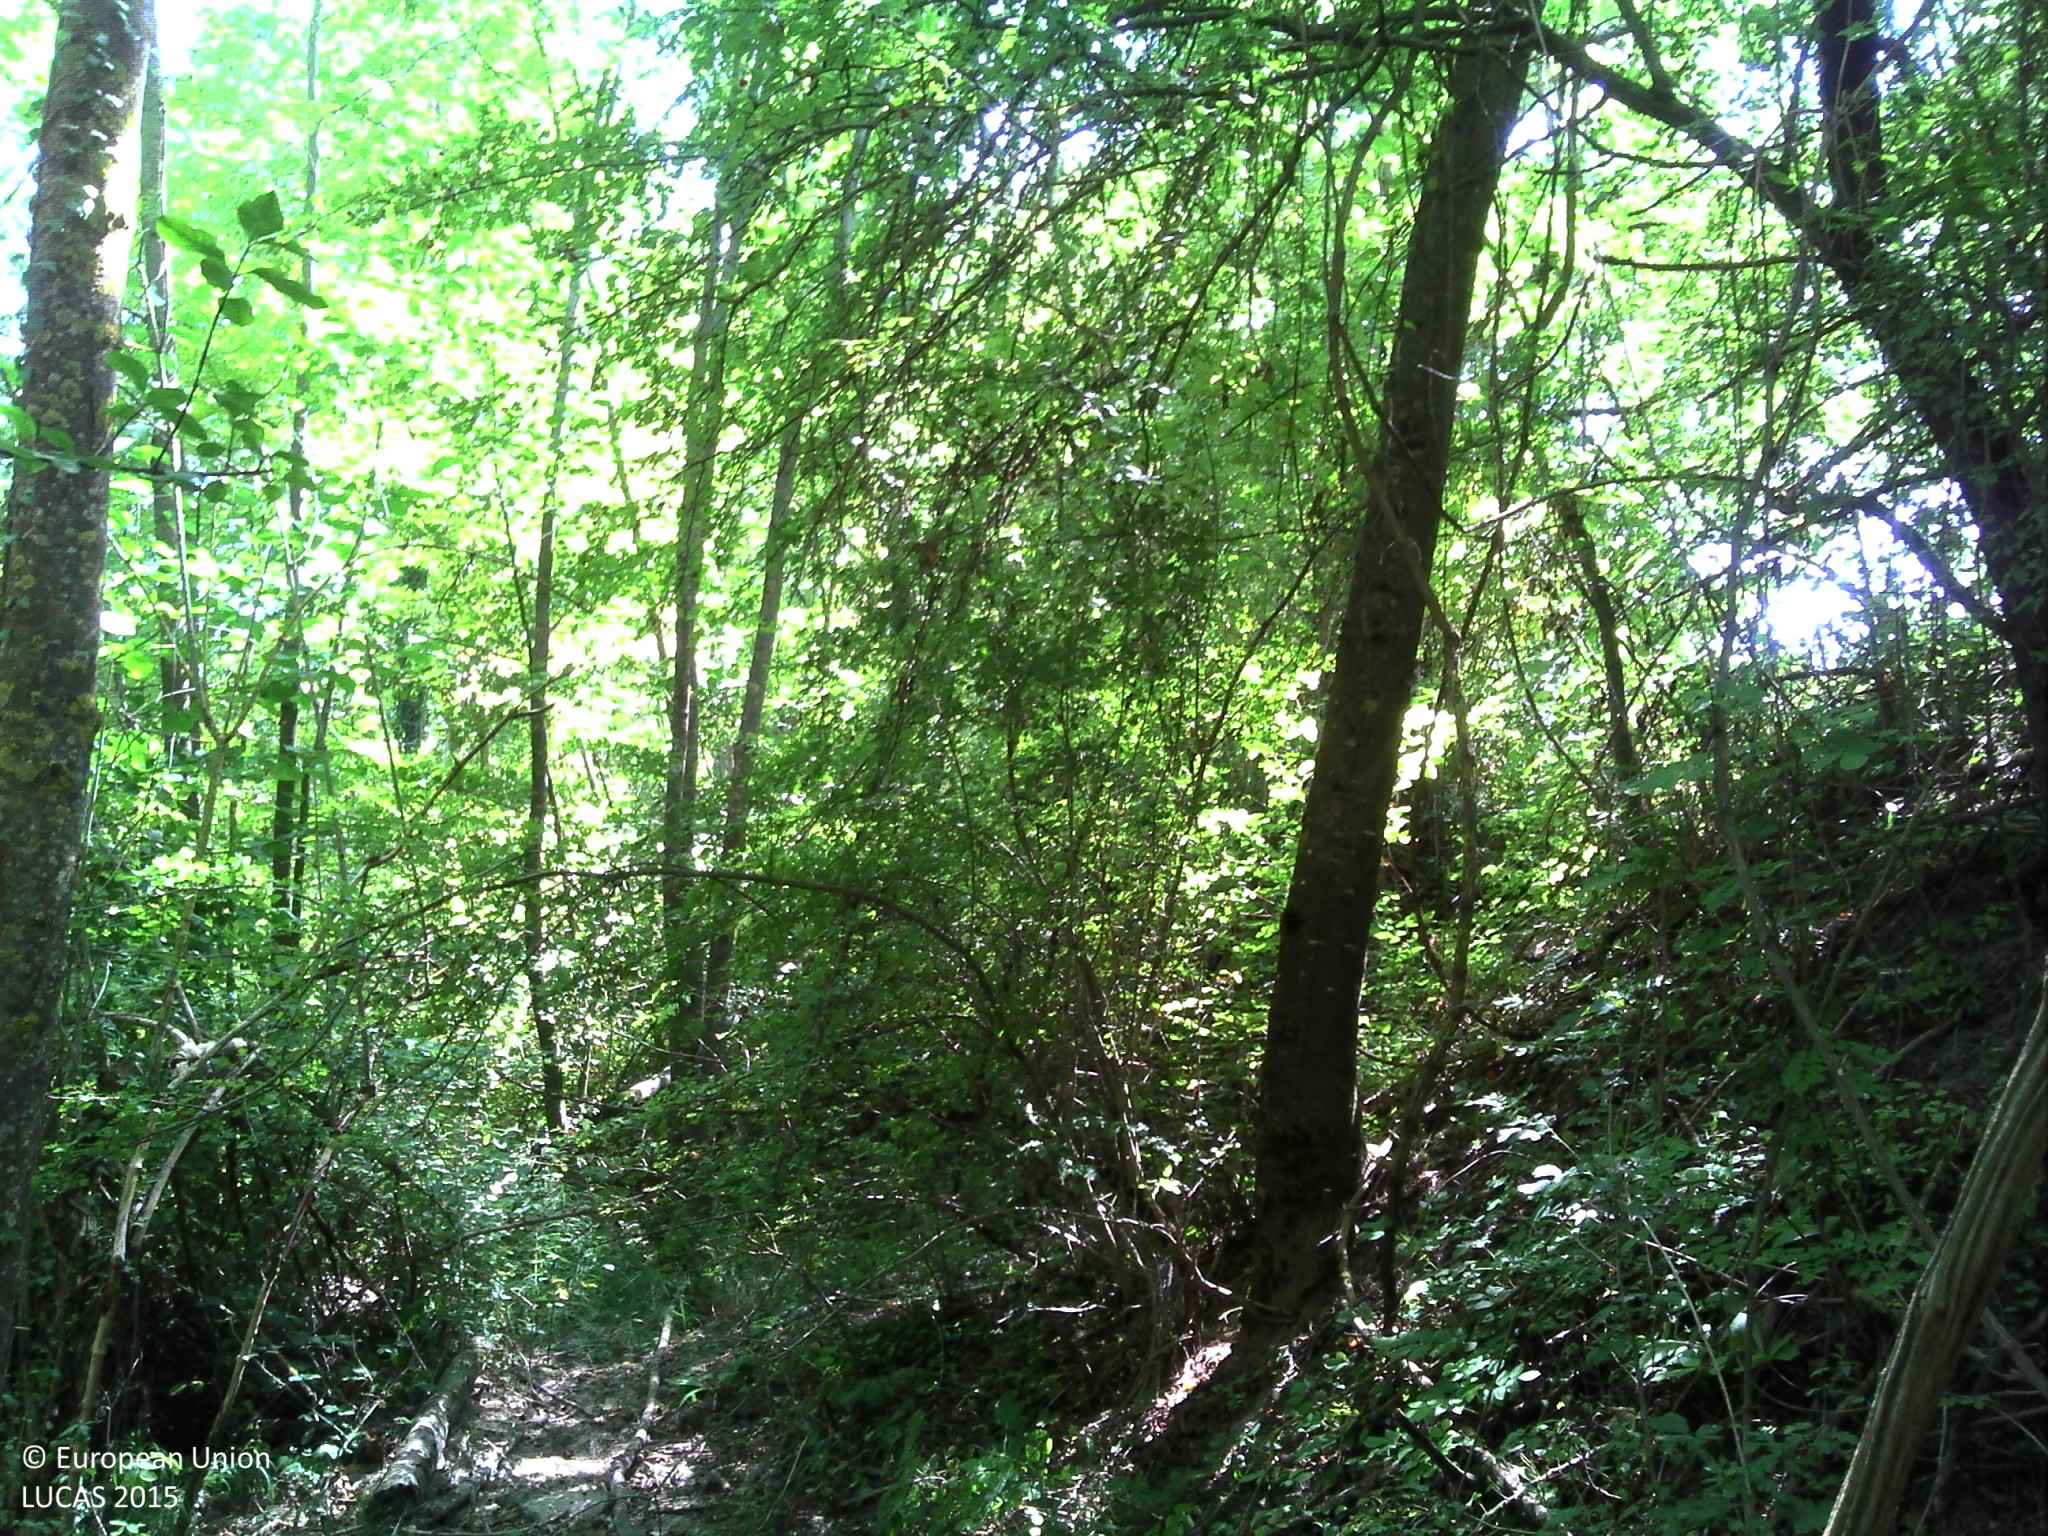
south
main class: Woodland
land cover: Broadleaved woodland
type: mesophytic deciduous forest
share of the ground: > 75 %
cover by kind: broadleaved forest trees 95 %, coniferous forest trees 5 %
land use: Semi-natural and natural areas not in use
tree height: > 5 m
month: September
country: FR
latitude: 44.5976
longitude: 5.1313
